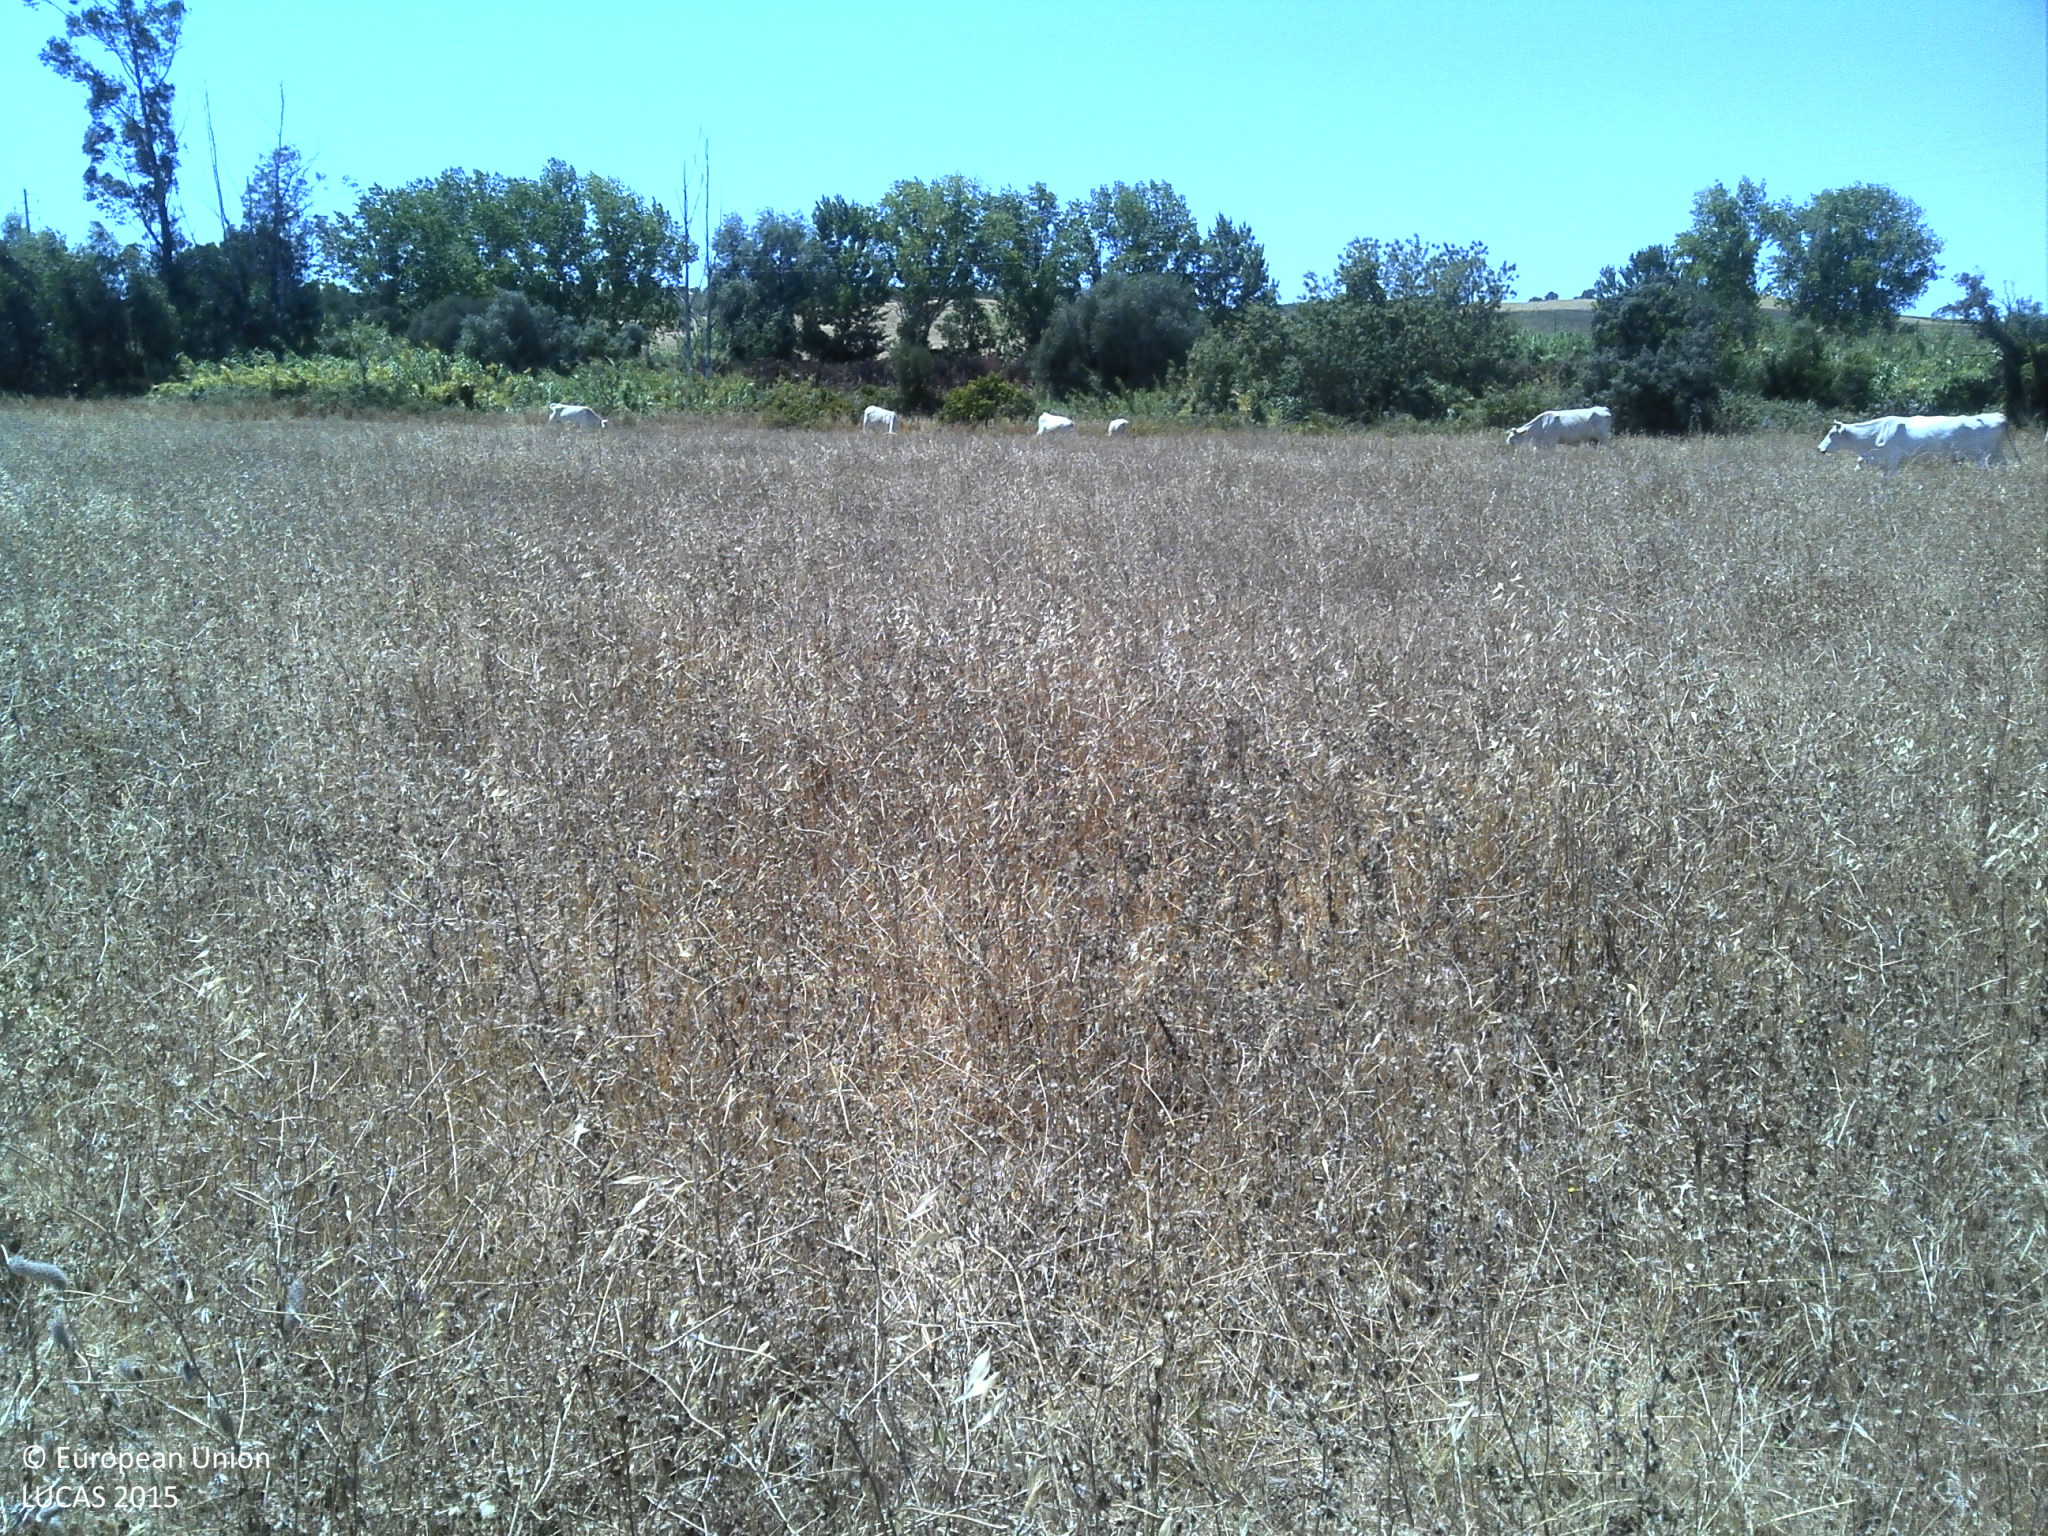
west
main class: Grassland
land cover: Grassland without tree/shrub cover
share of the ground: > 75 %
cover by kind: herbaceous plants 90 %, unconsolidated bare surface 10 %
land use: Agriculture (excluding fallow land and kitchen gardens)
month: July
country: PT
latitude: 38.0374
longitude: -8.0693
